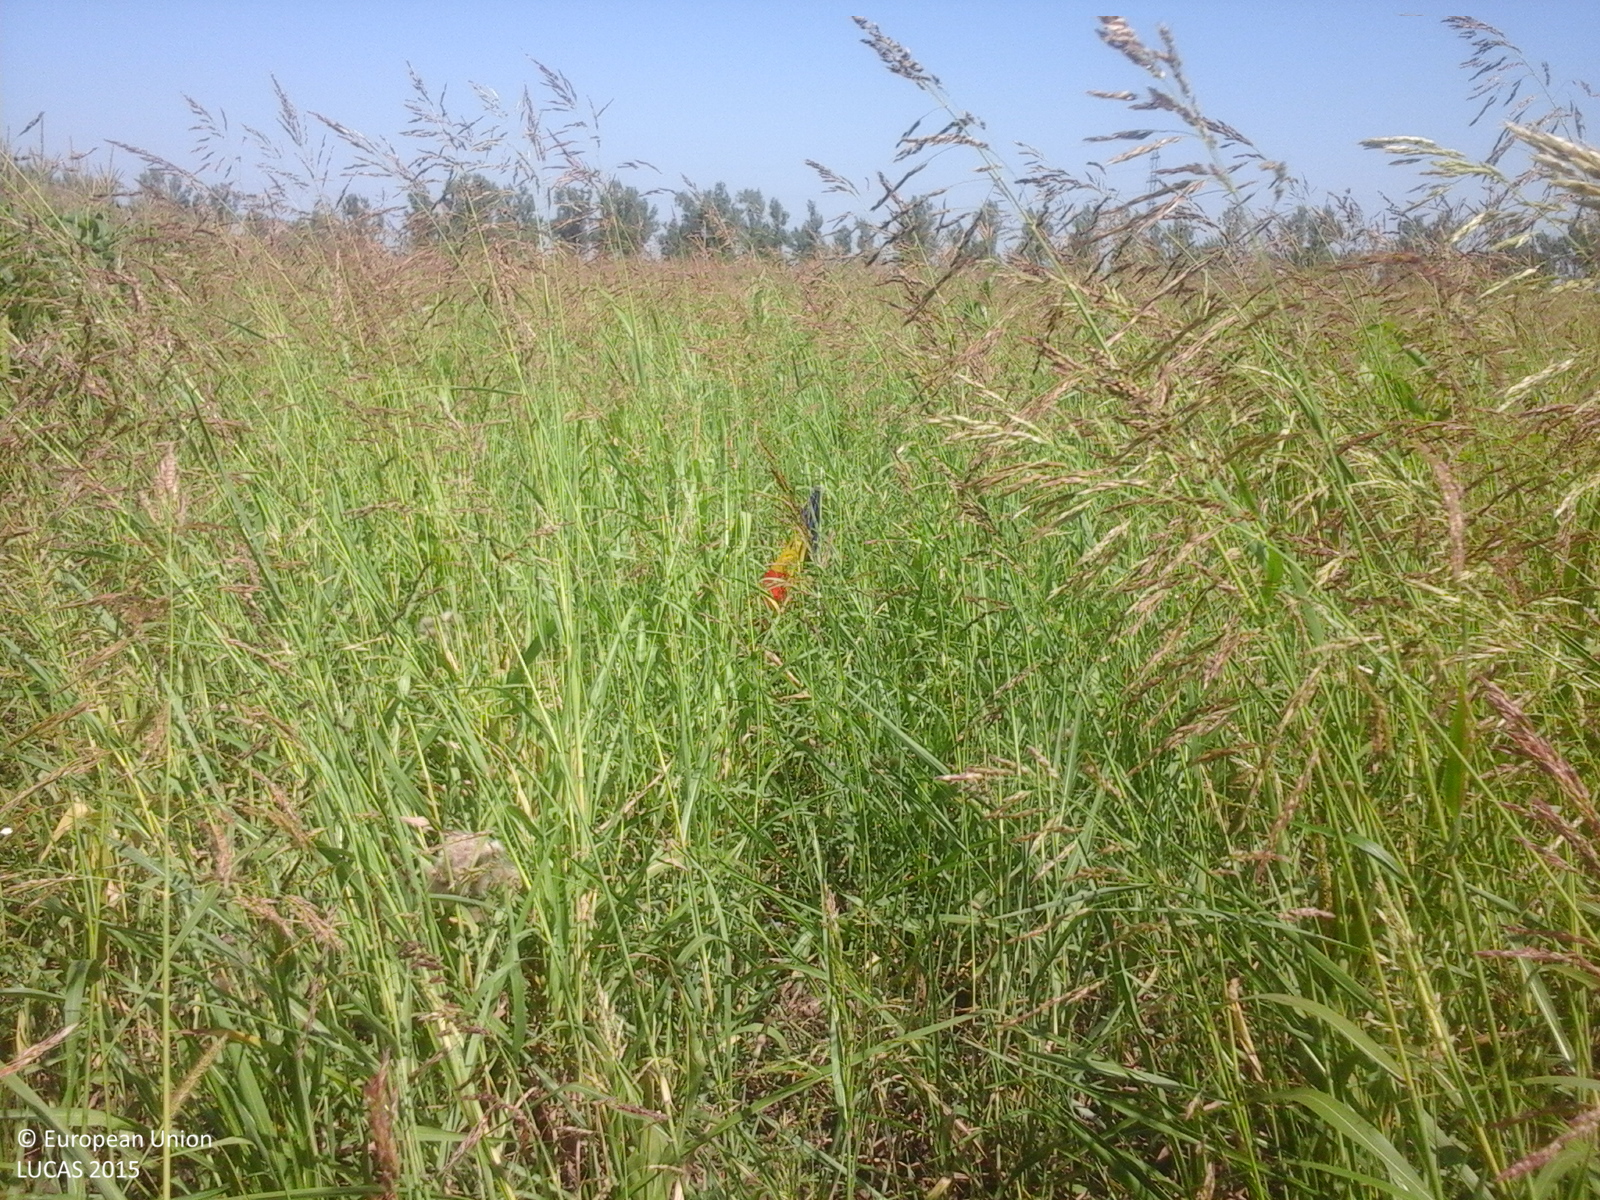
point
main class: Grassland
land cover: Spontaneously vegetated surfaces
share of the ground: 50 - 75 %
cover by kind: herbaceous plants 100 %
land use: Fallow land
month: July
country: RO
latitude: 44.2331
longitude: 26.6044
